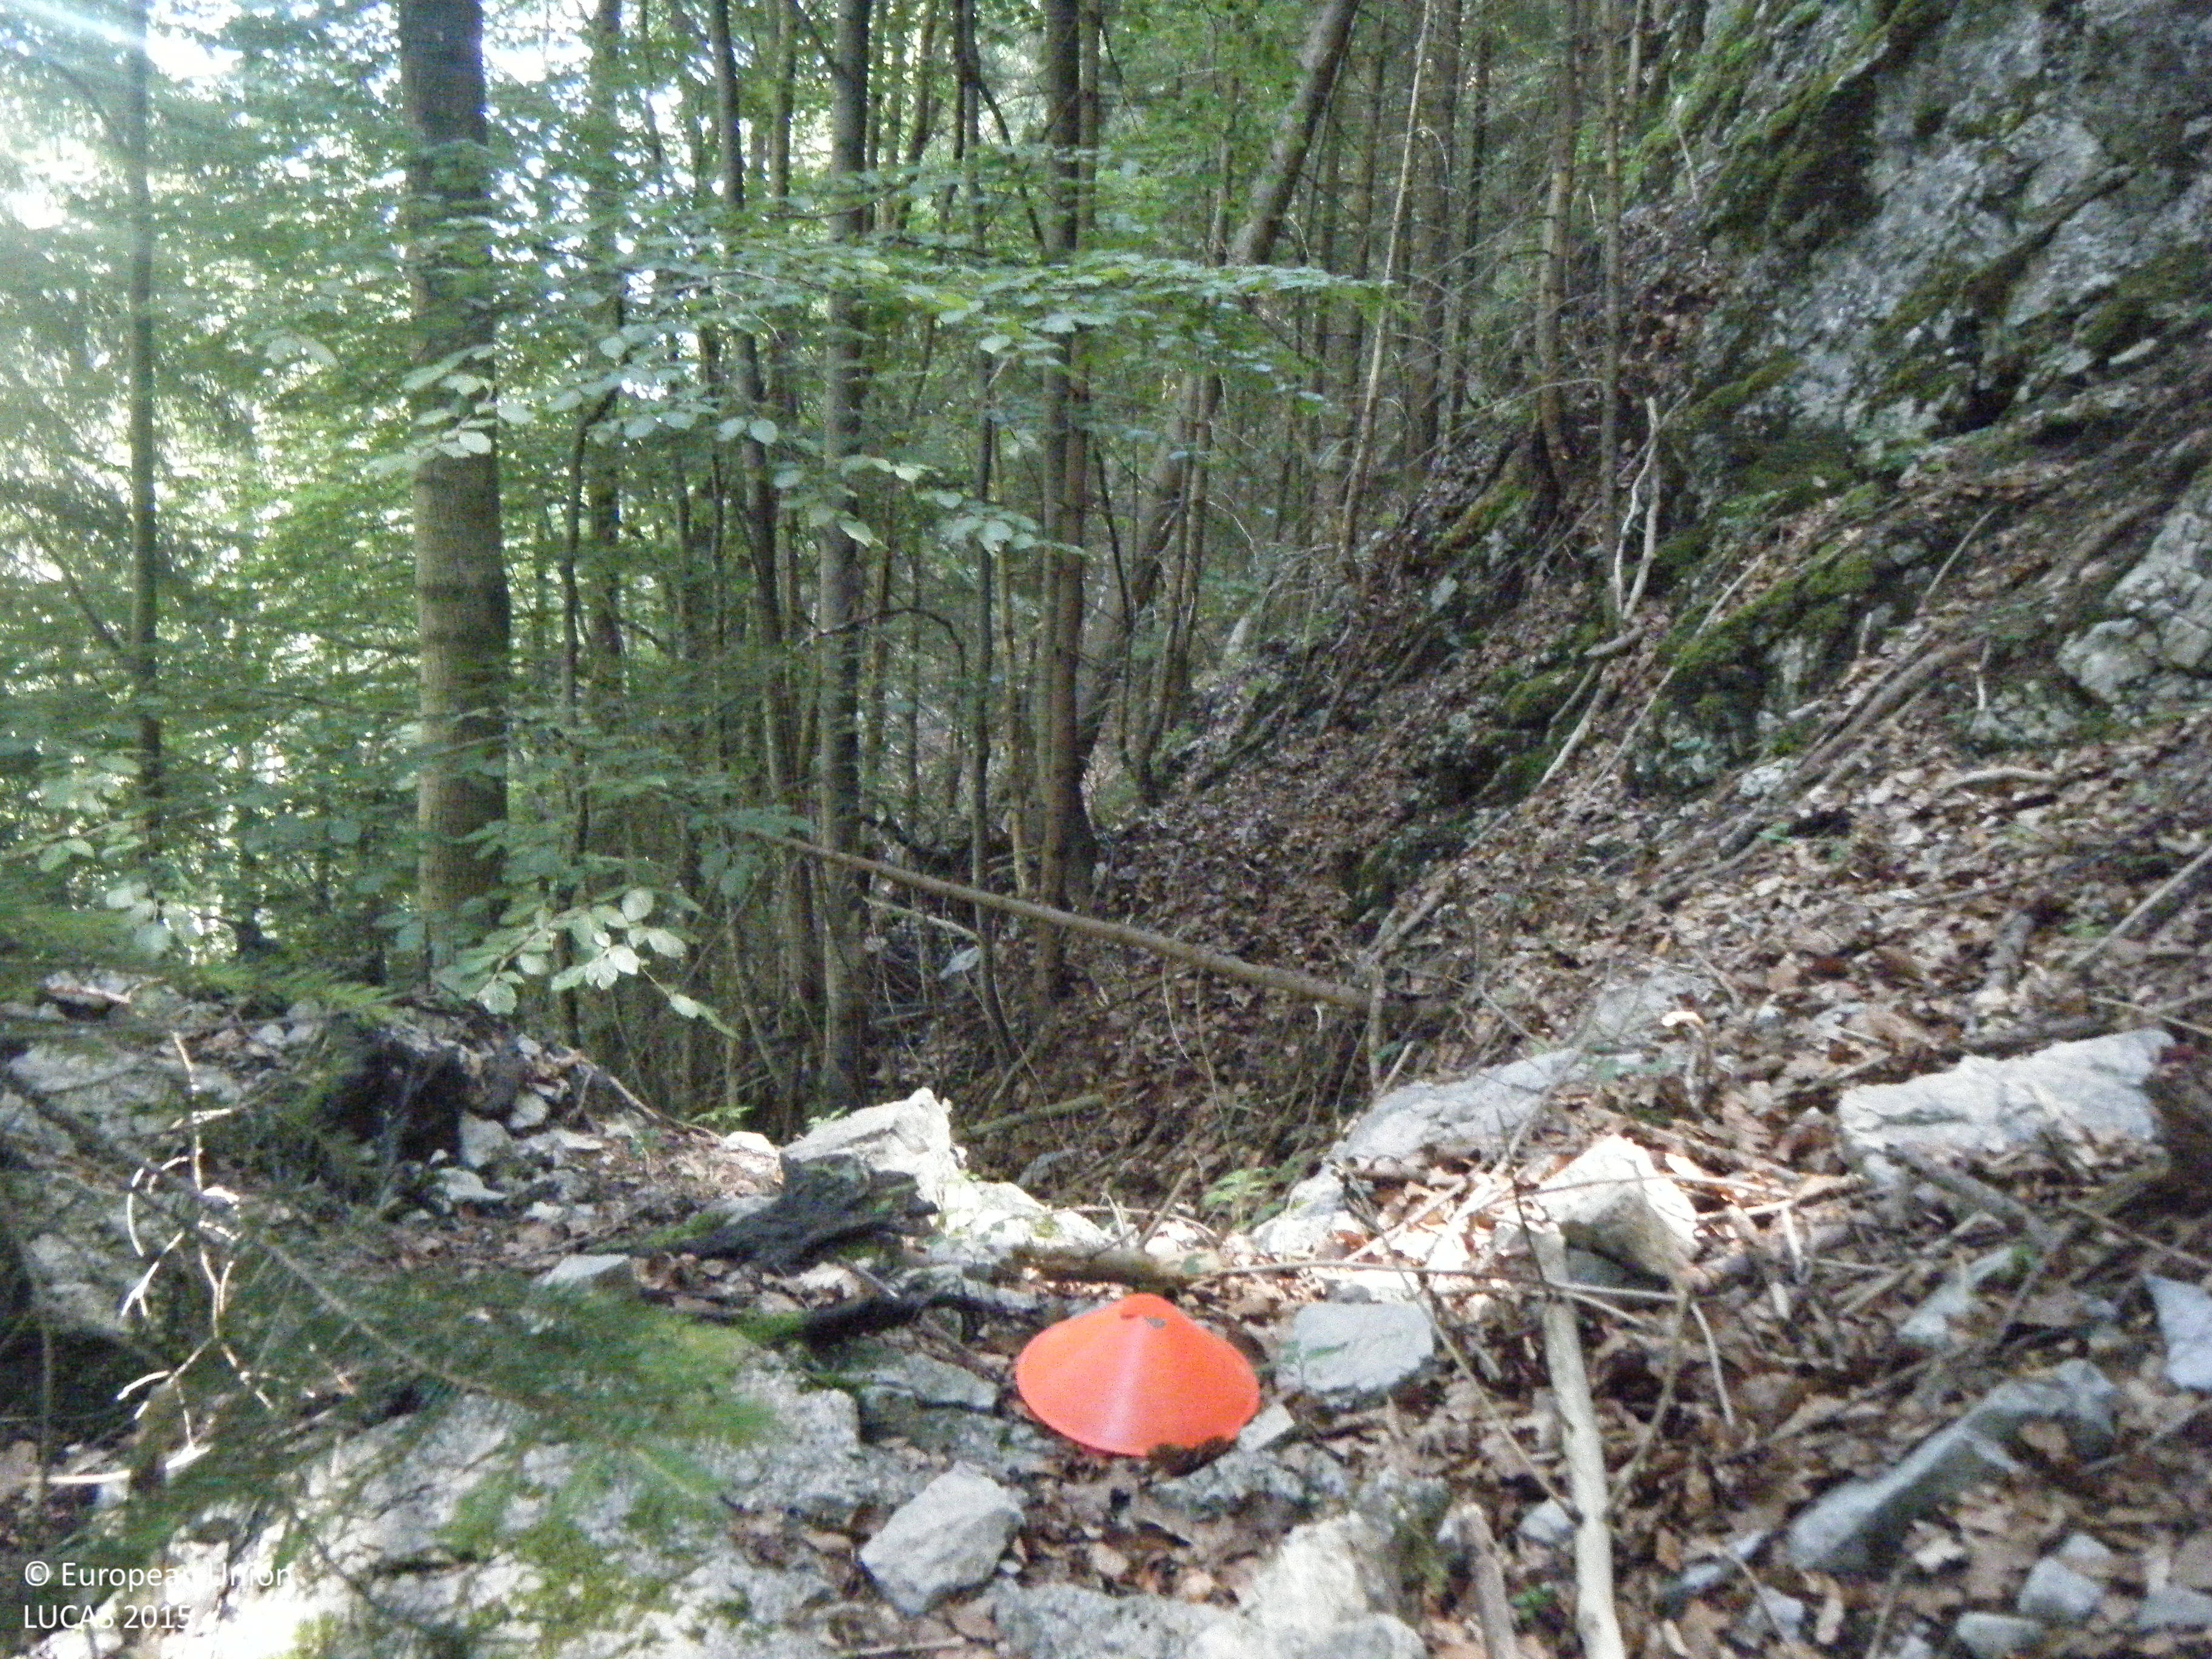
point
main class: Woodland
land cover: Spruce dominated mixed woodland
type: mountainous beech forest
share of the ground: > 75 %
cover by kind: broadleaved forest trees 65 %, coniferous forest trees 25 %, consolidated bare surface 10 %
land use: Forestry
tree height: > 5 m
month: July
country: AT
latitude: 47.7953
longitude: 13.3229
